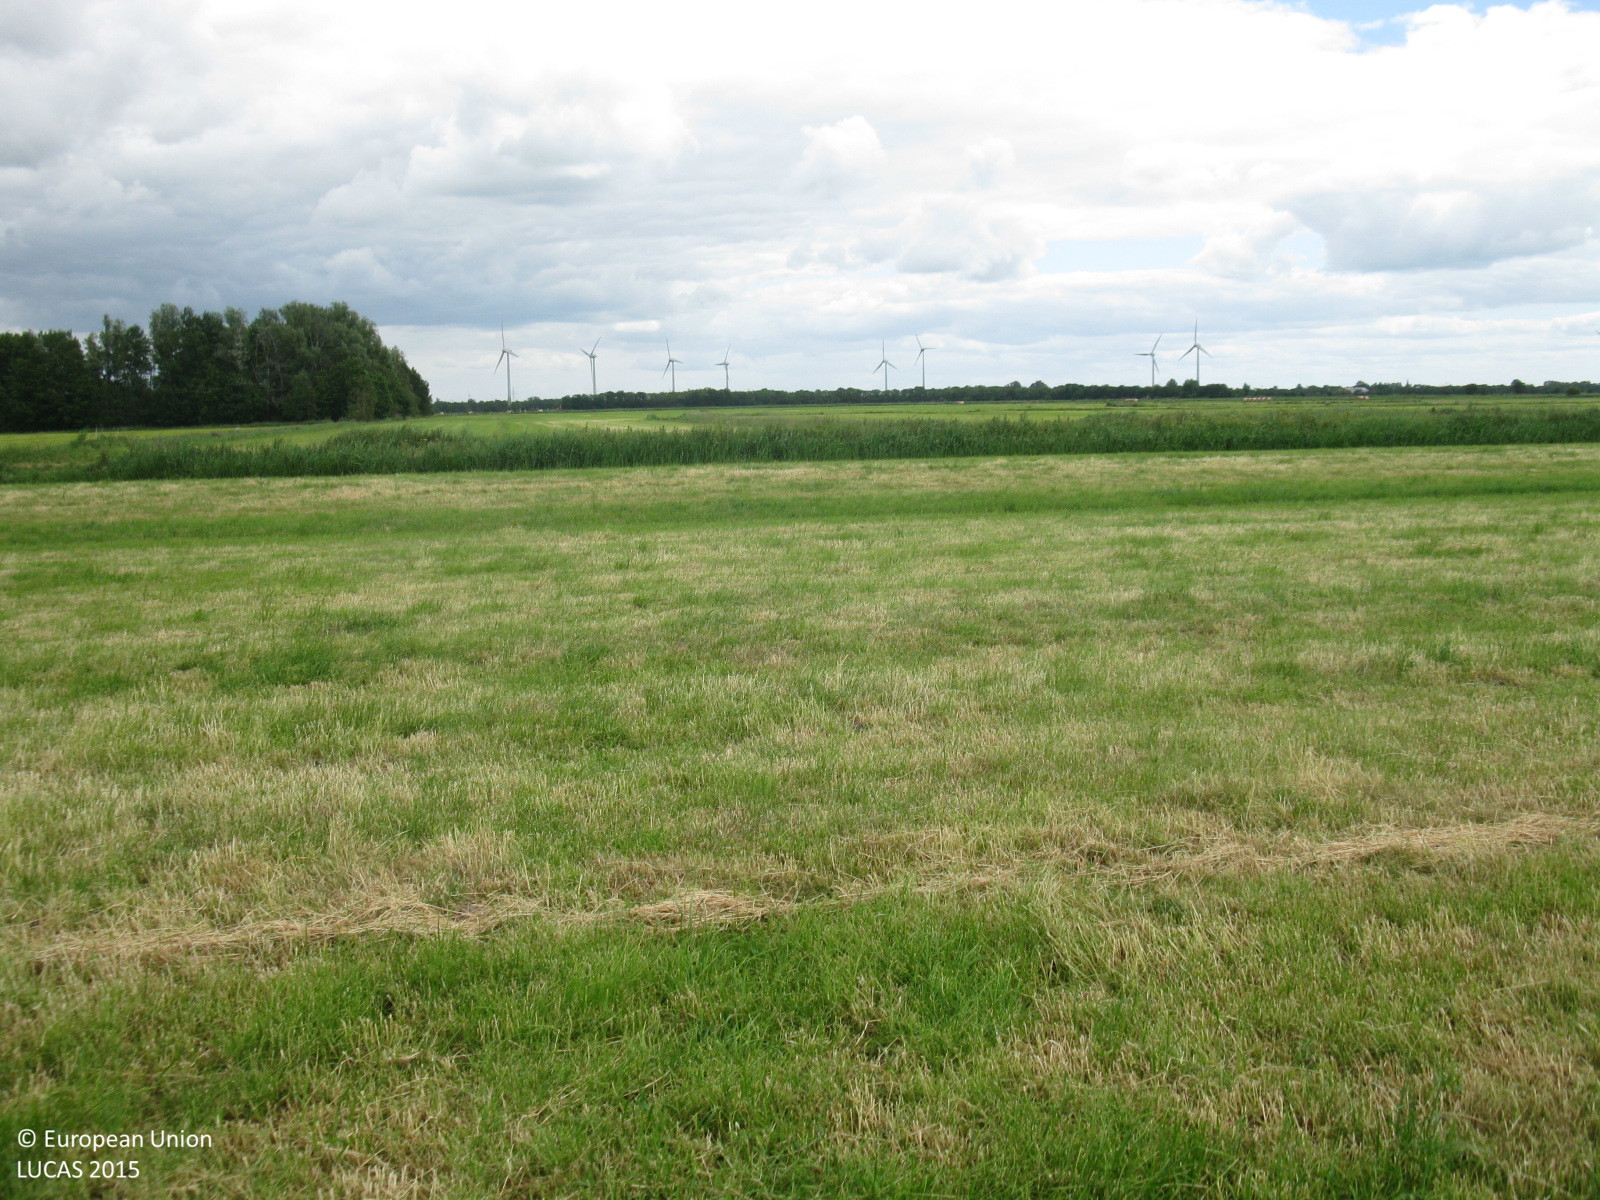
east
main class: Grassland
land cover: Grassland without tree/shrub cover
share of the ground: > 75 %
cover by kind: herbaceous plants 100 %
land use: Agriculture (excluding fallow land and kitchen gardens)
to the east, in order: Grassland without tree/shrub cover; Ditches and canals; Grass margins; Tracks; Grass margins; Inland fresh running water; Grassland without tree/shrub cover; Ditches and canals; Grassland without tree/shrub cover; Ditches and canals; Grassland without tree/shrub cover
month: June
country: DE
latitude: 53.3195
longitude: 7.3735
